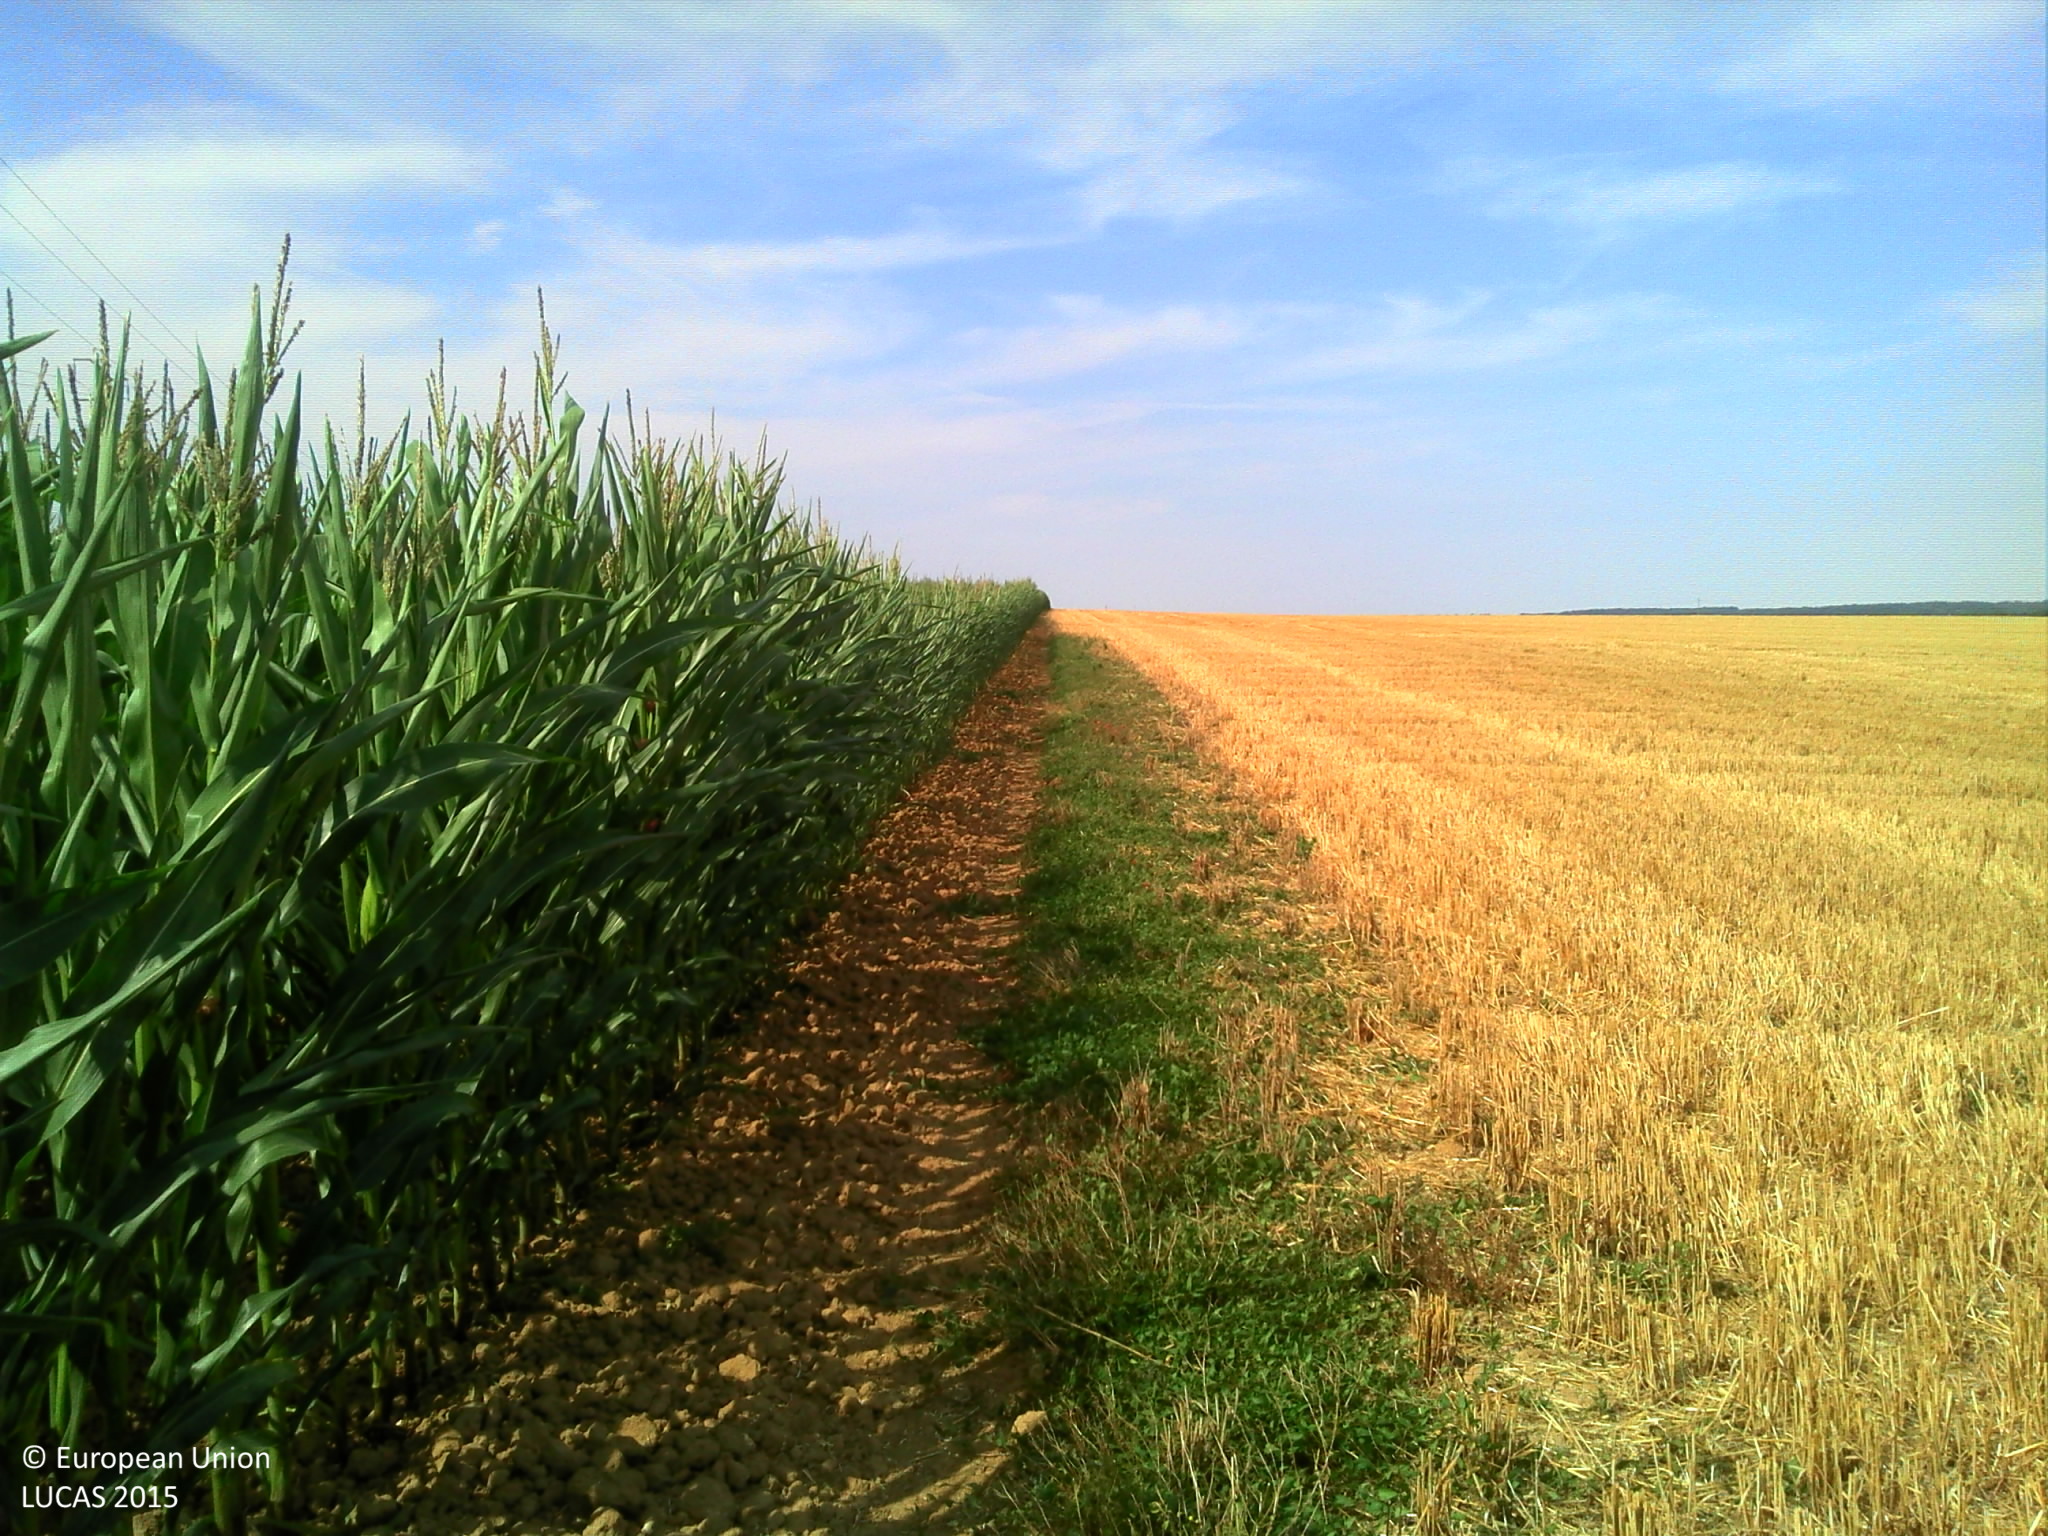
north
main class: Cropland
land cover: Maize
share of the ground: > 75 %
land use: Agriculture (excluding fallow land and kitchen gardens)
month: August
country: FR
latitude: 48.6532
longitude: 3.3279
